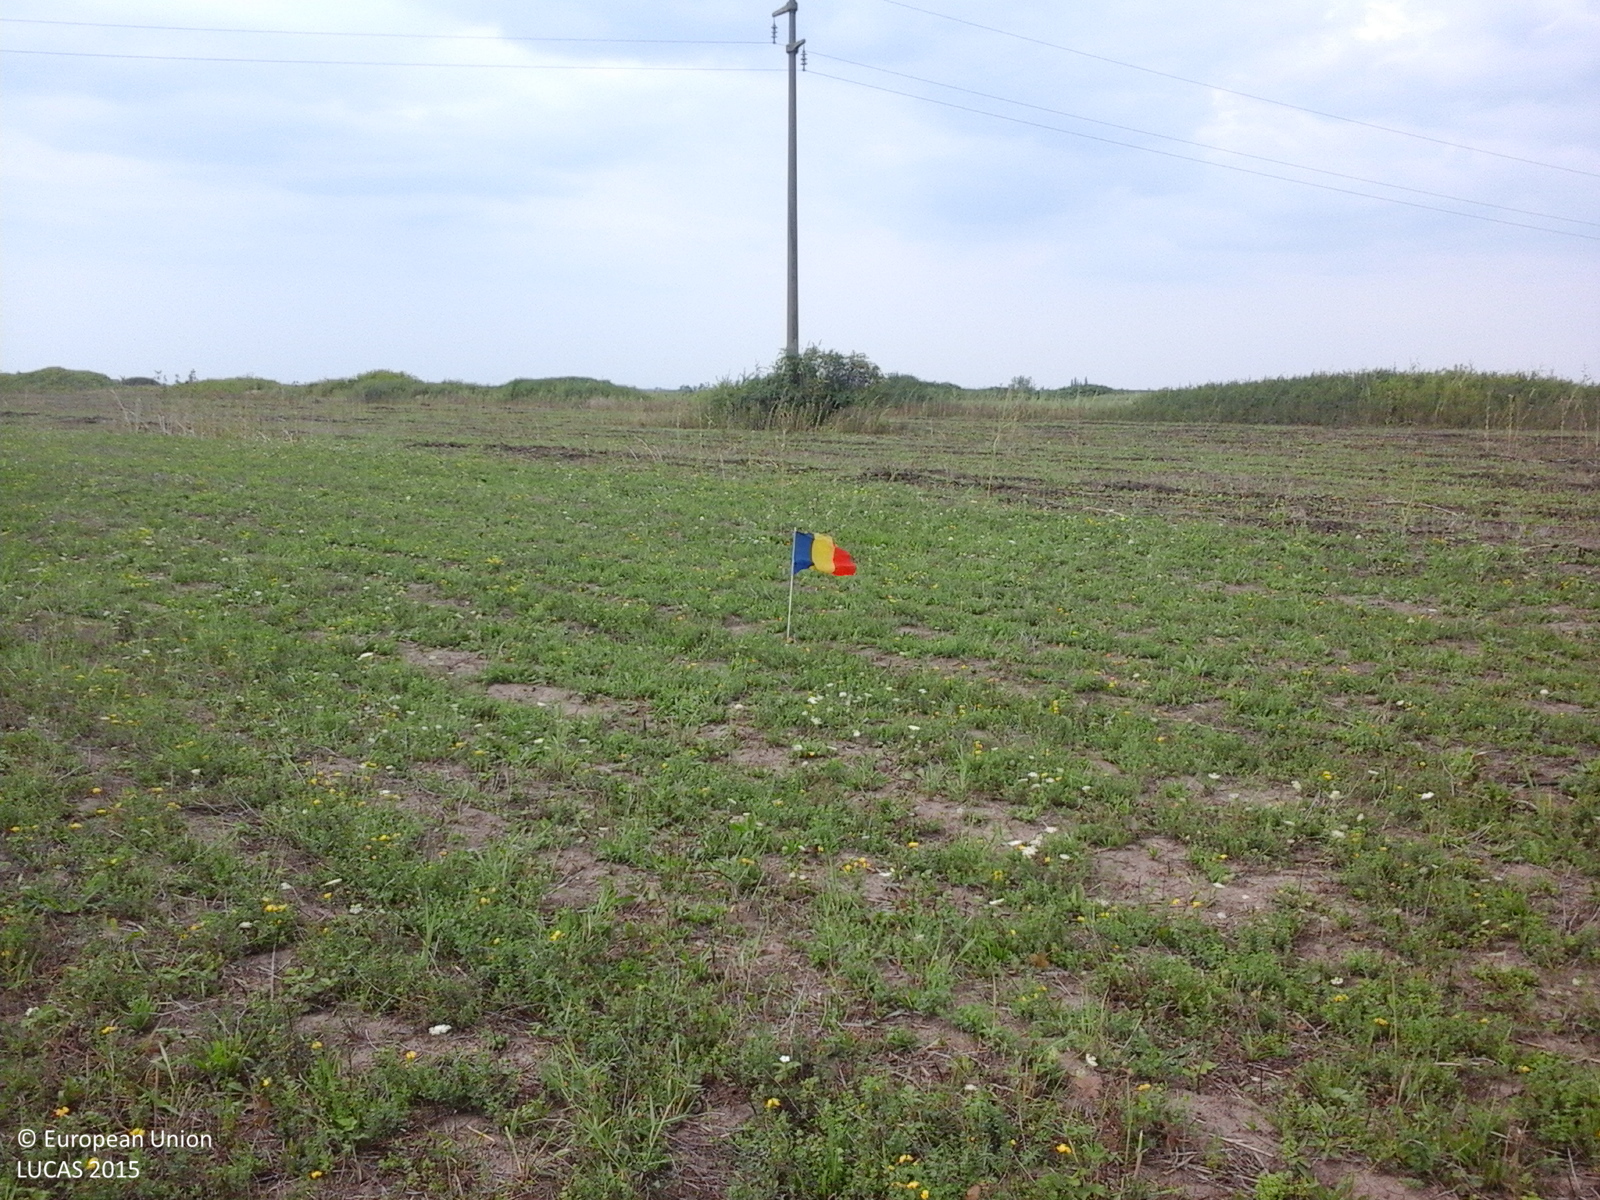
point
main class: Grassland
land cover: Spontaneously vegetated surfaces
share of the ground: > 75 %
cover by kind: herbaceous plants 100 %
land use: Fallow land
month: August
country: RO
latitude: 46.3908
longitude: 21.5993
